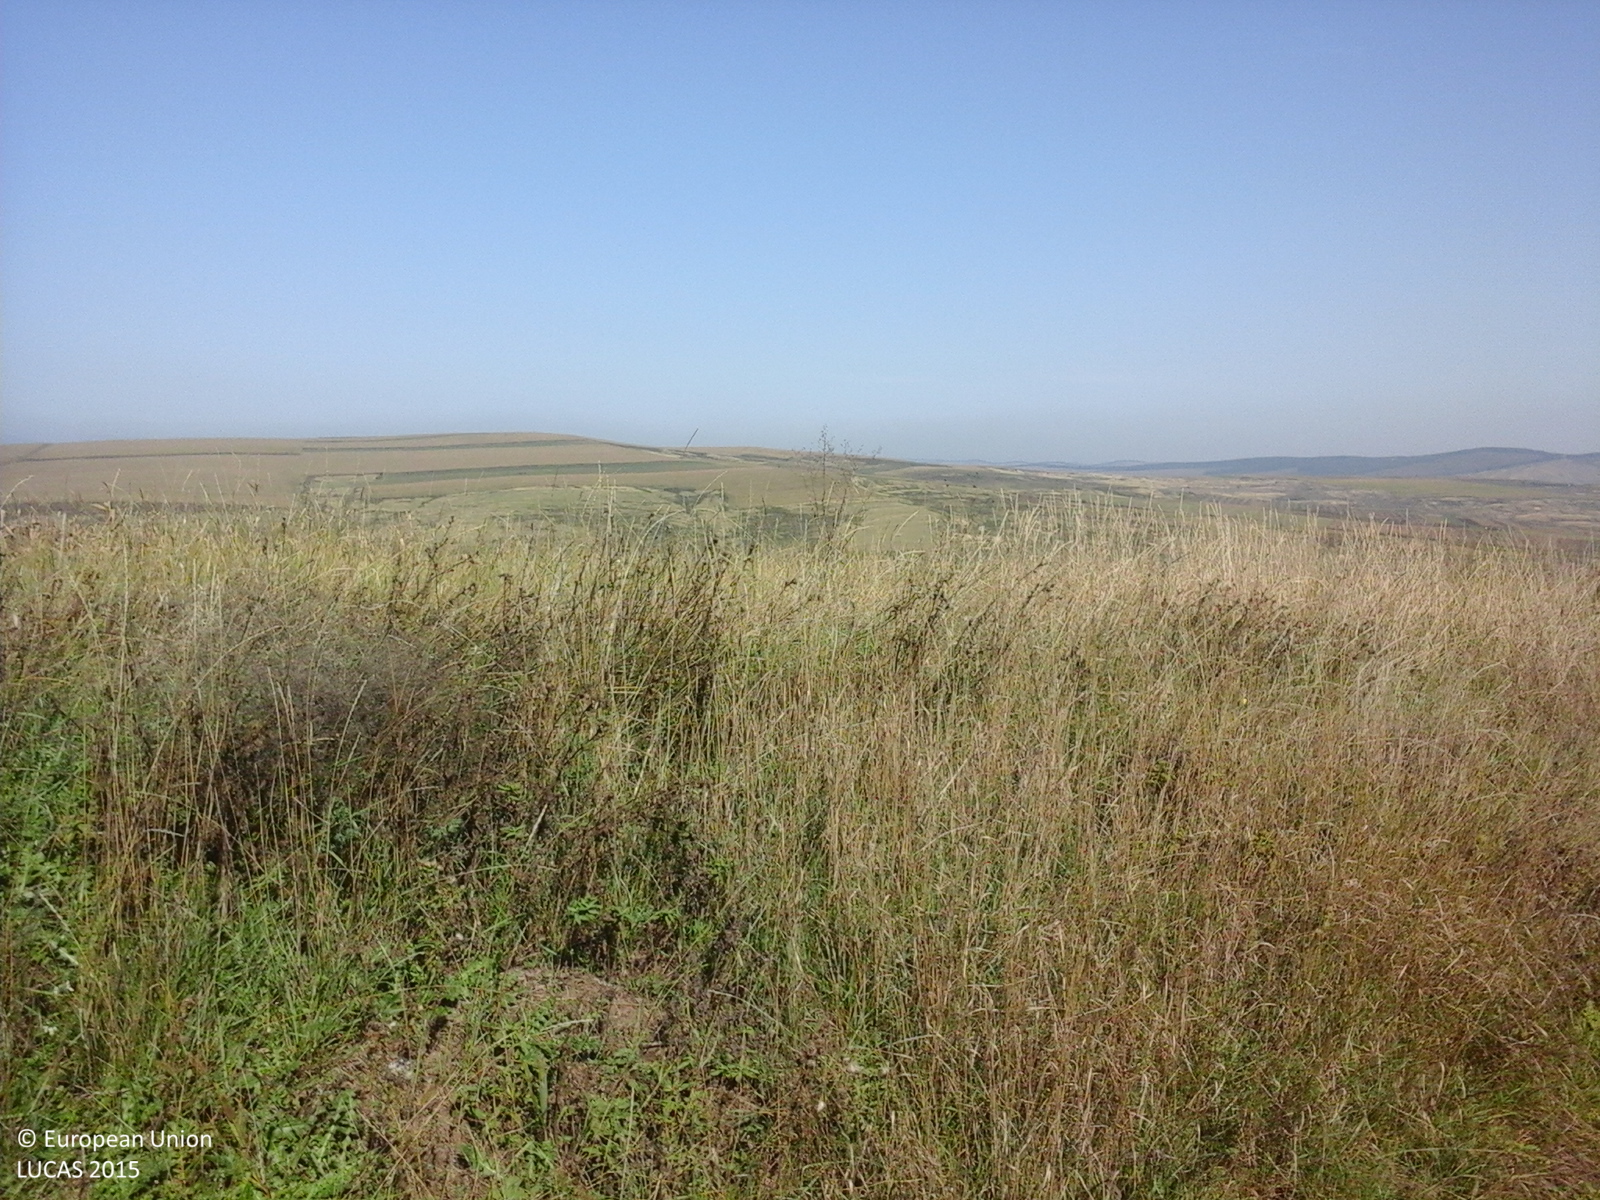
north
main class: Cropland
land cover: Maize
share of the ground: > 75 %
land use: Agriculture (excluding fallow land and kitchen gardens)
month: October
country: RO
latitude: 46.1203
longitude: 23.8532
